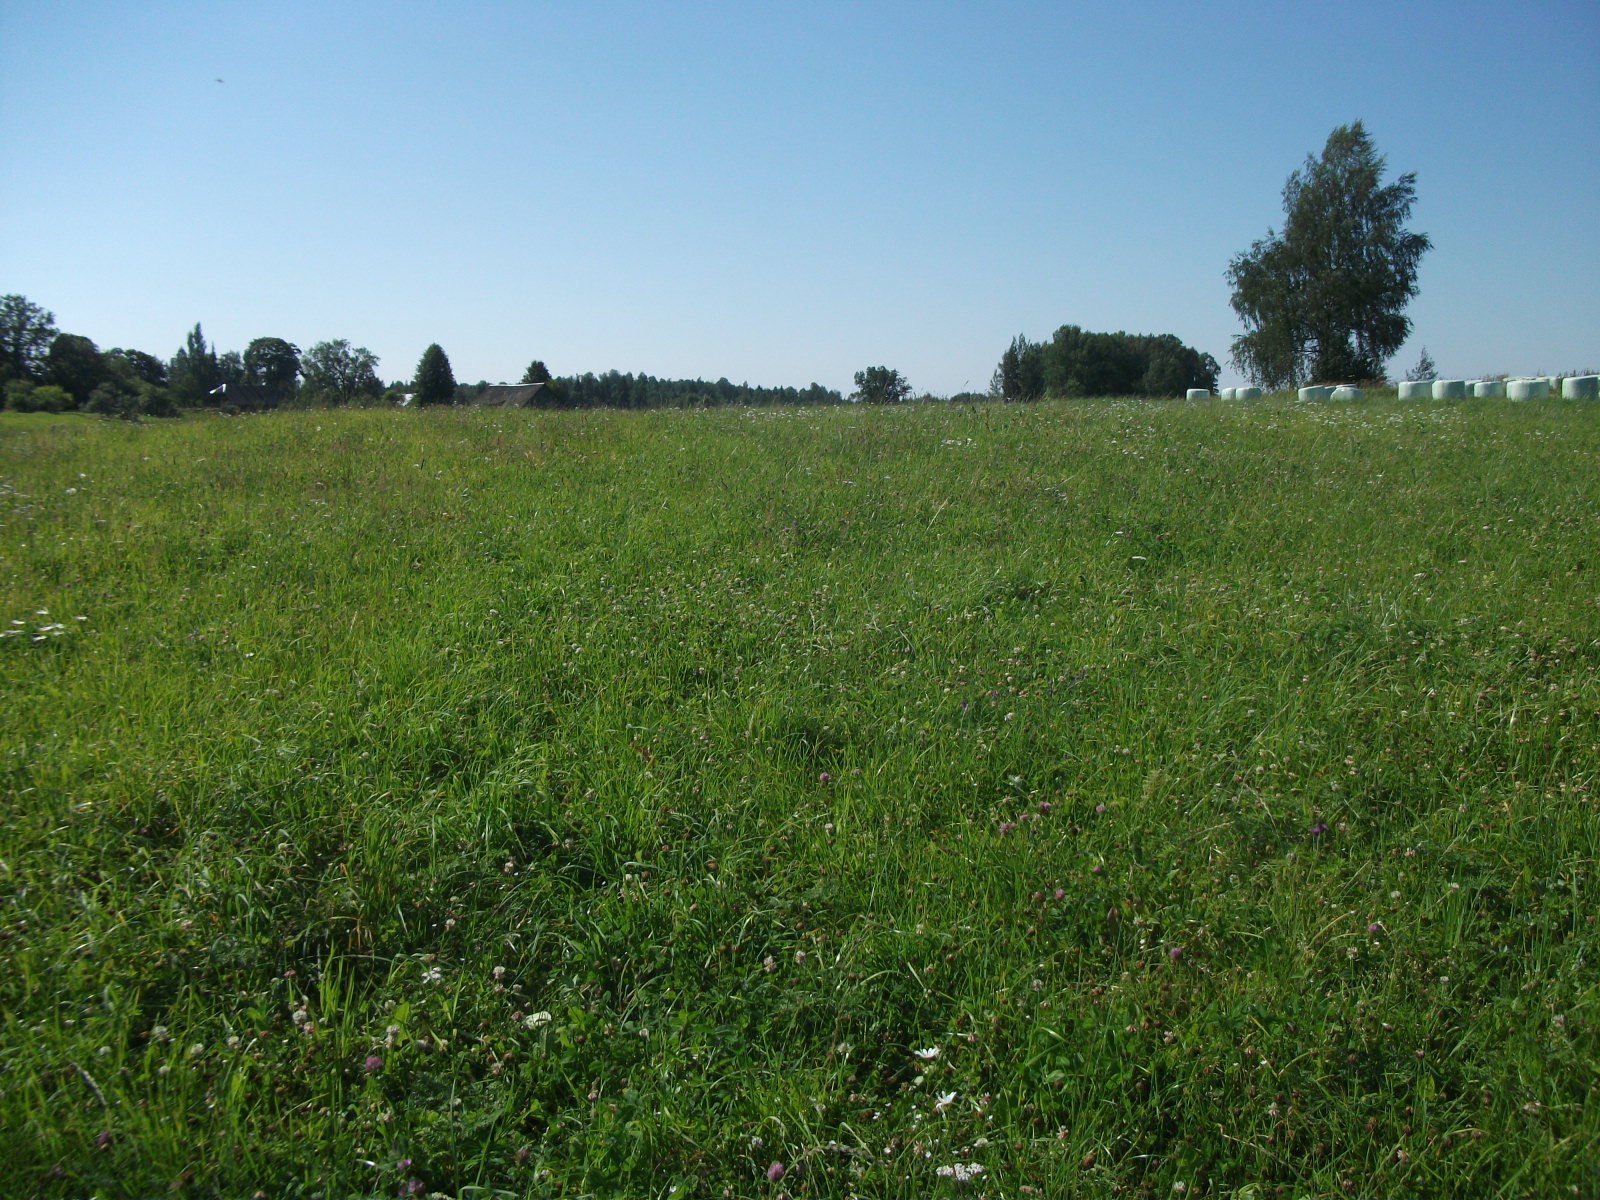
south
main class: Grassland
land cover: Grassland without tree/shrub cover
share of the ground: > 75 %
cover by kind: herbaceous plants 100 %
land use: Agriculture (excluding fallow land and kitchen gardens)
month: August
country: LV
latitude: 56.9284
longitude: 25.7845
